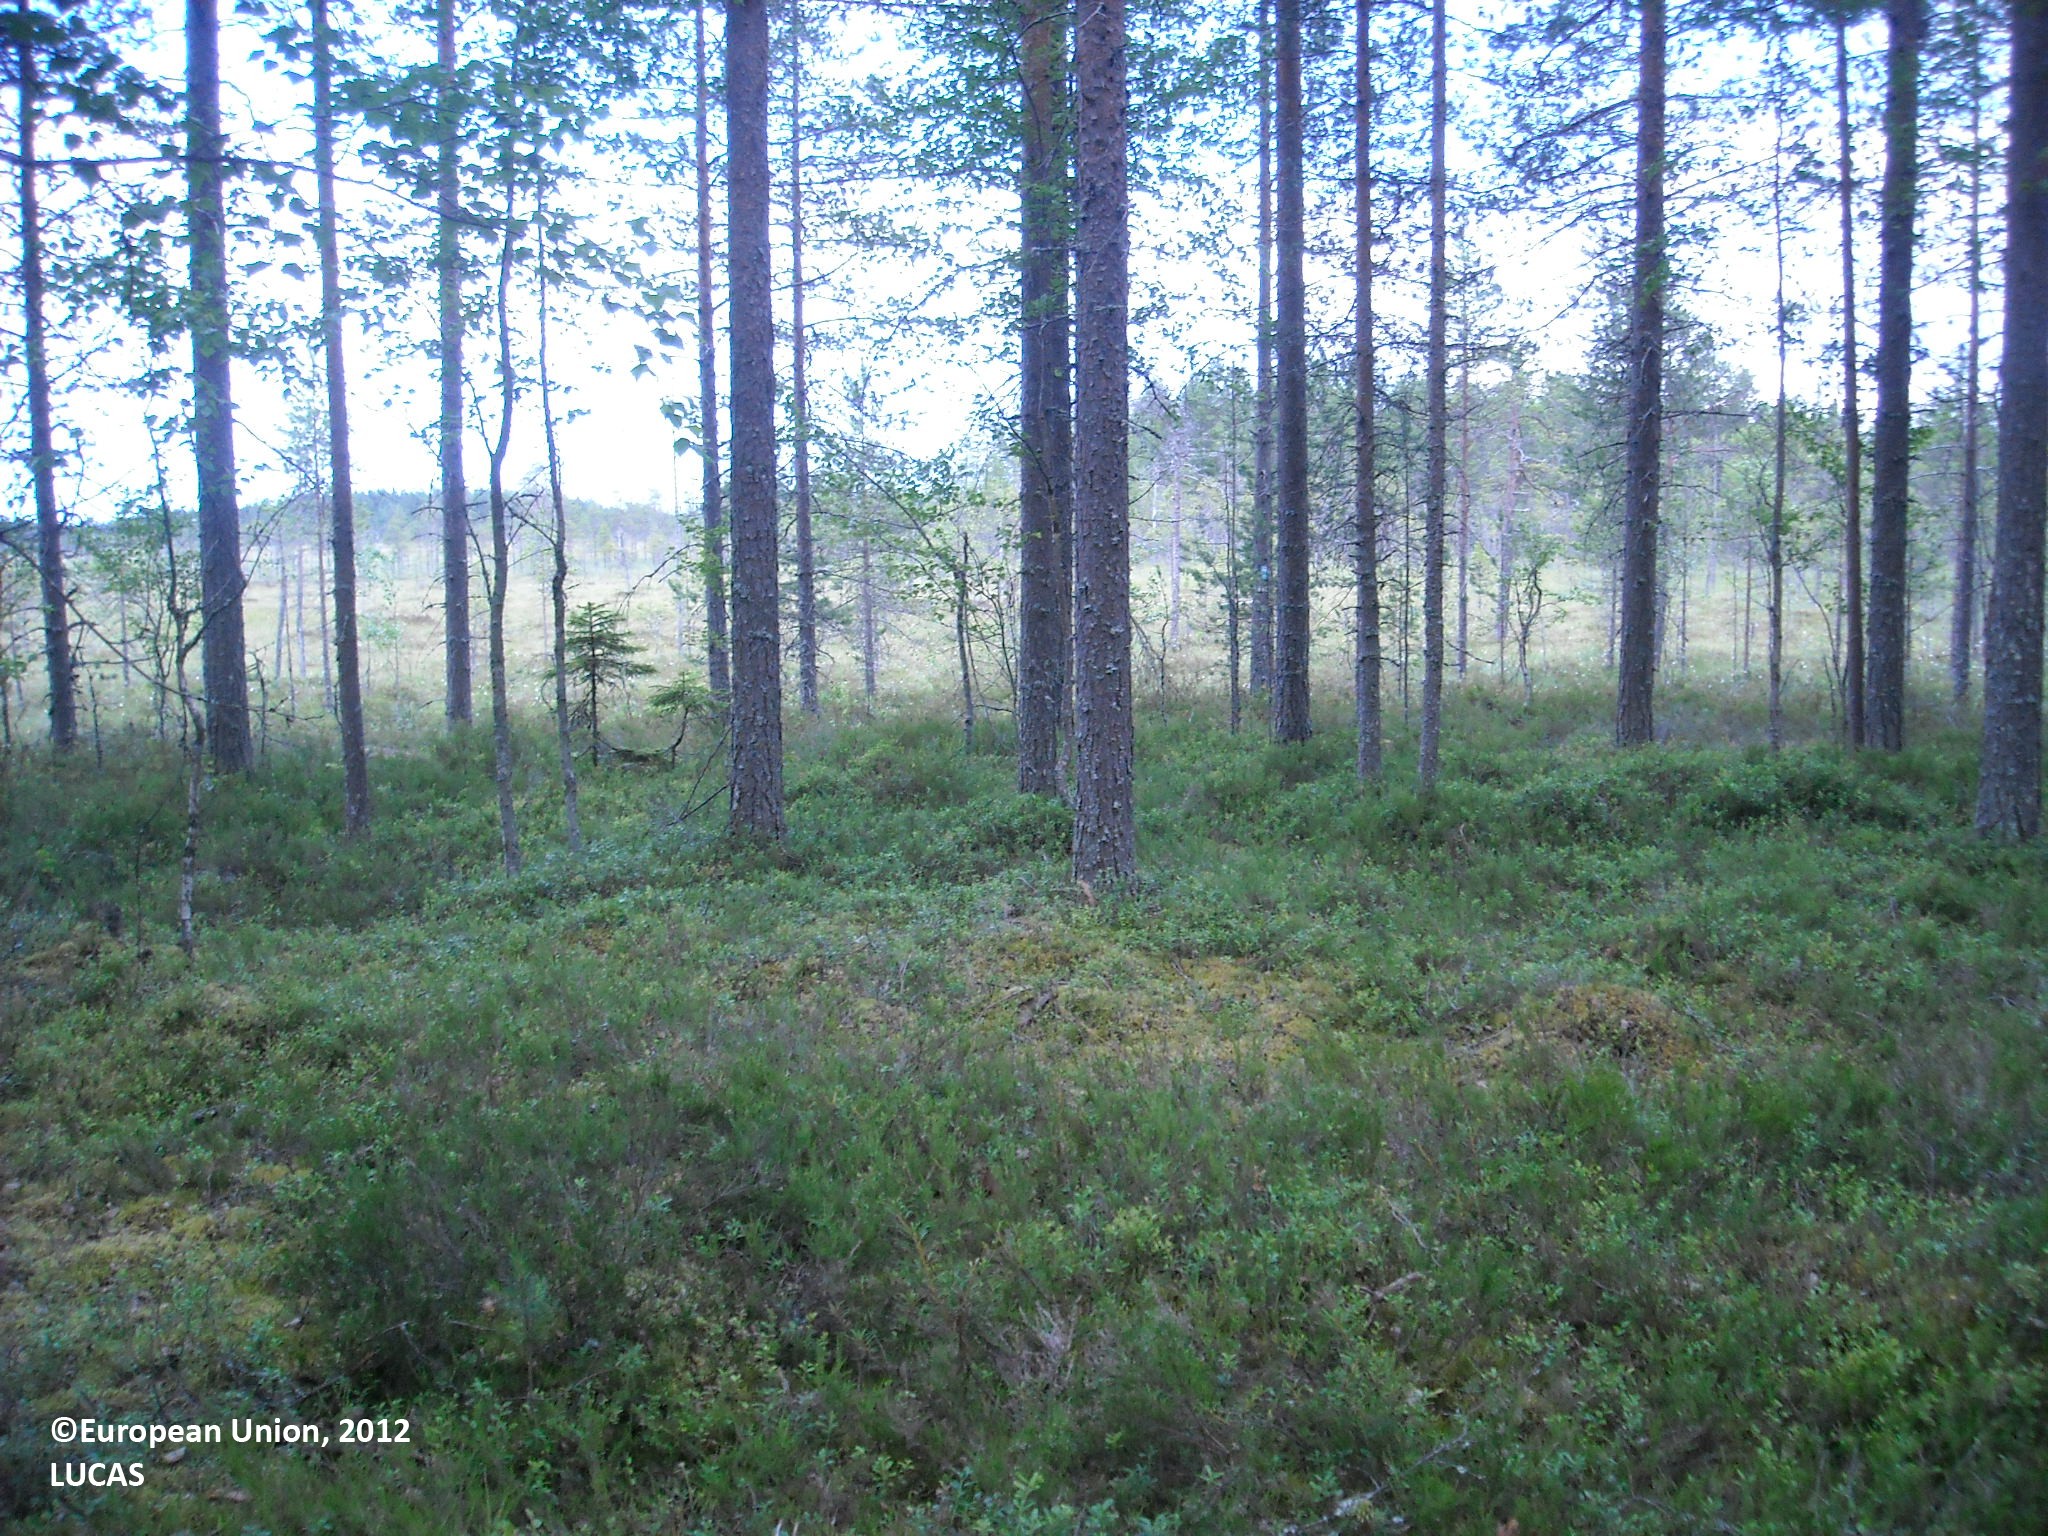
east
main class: Woodland
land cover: Pine dominated coniferous woodland
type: boreal forest
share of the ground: > 75 %
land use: Forestry
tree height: > 5 m
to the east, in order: Pine dominated coniferous woodland; Peatbogs; Pine dominated coniferous woodland; Peatbogs
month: July
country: FI
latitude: 65.0440
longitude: 26.7026
